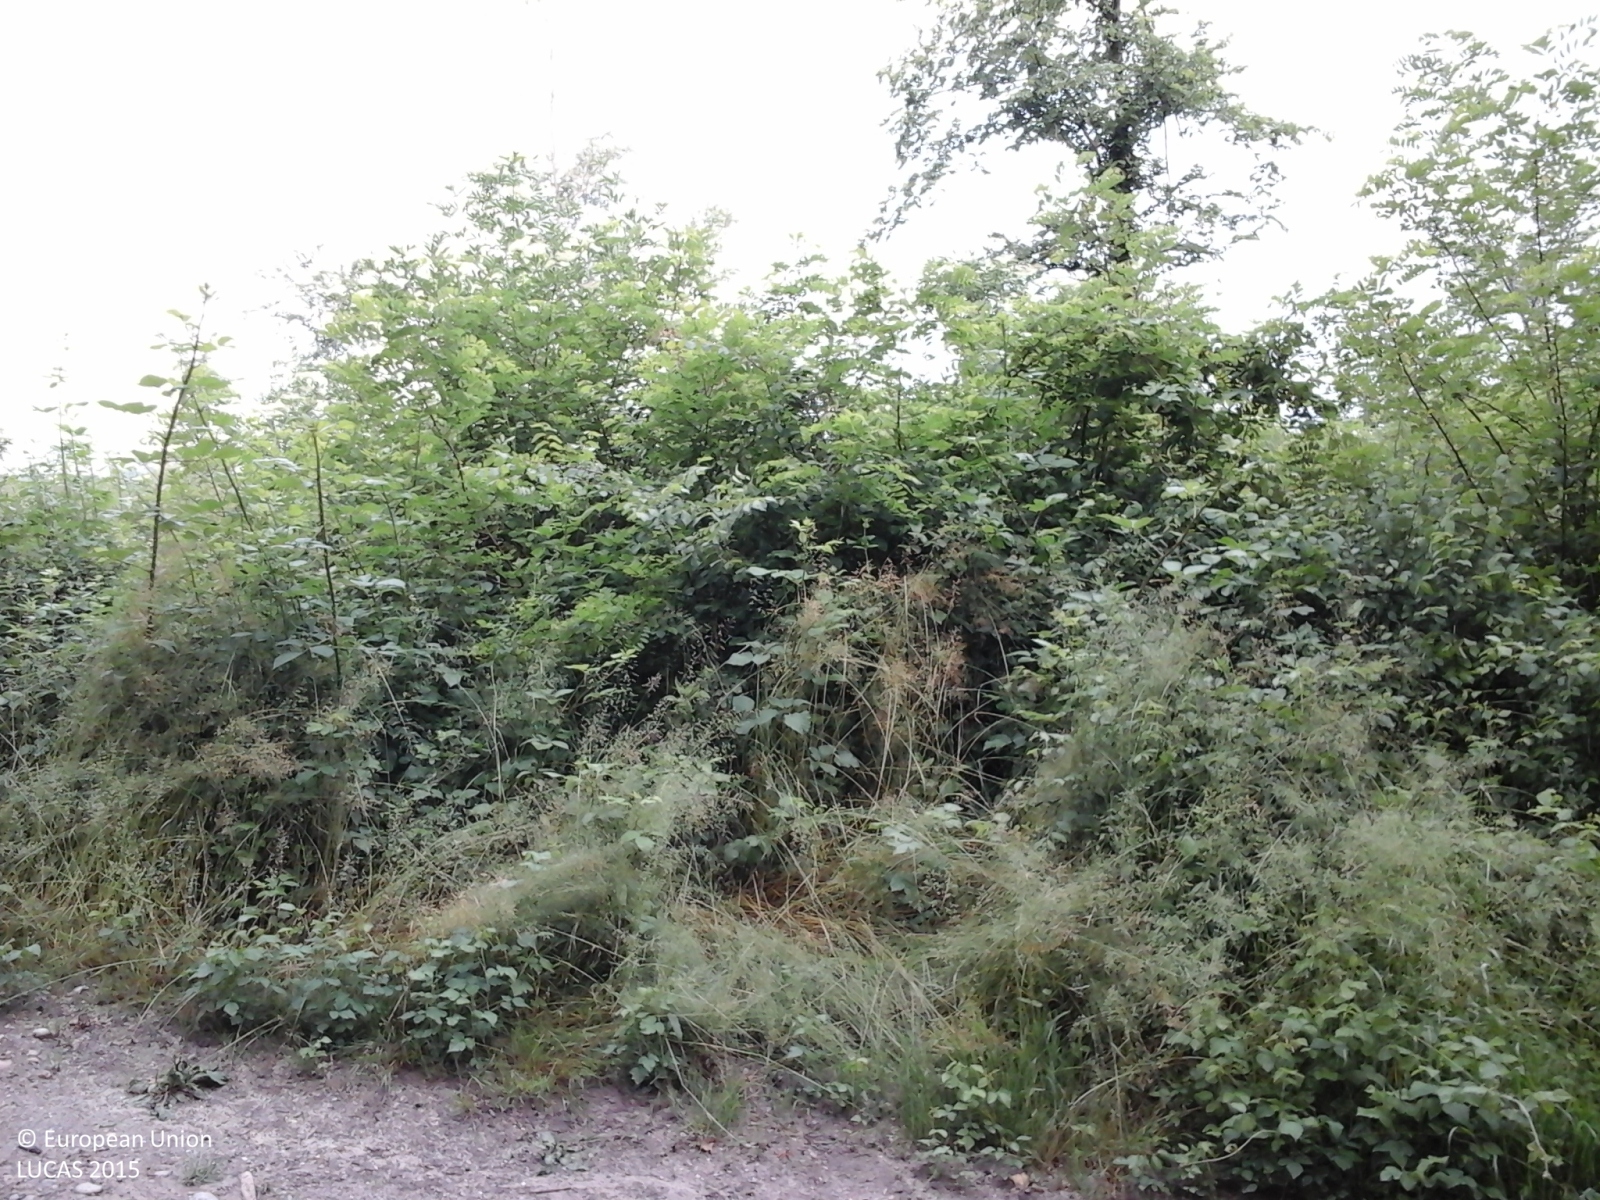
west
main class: Woodland
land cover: Broadleaved woodland
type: thermophilous deciduous forest
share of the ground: > 75 %
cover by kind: broadleaved forest trees 90 %, shrubs 10 %
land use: Forestry
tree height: > 5 m
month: May
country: IT
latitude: 44.6159
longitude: 7.7991
